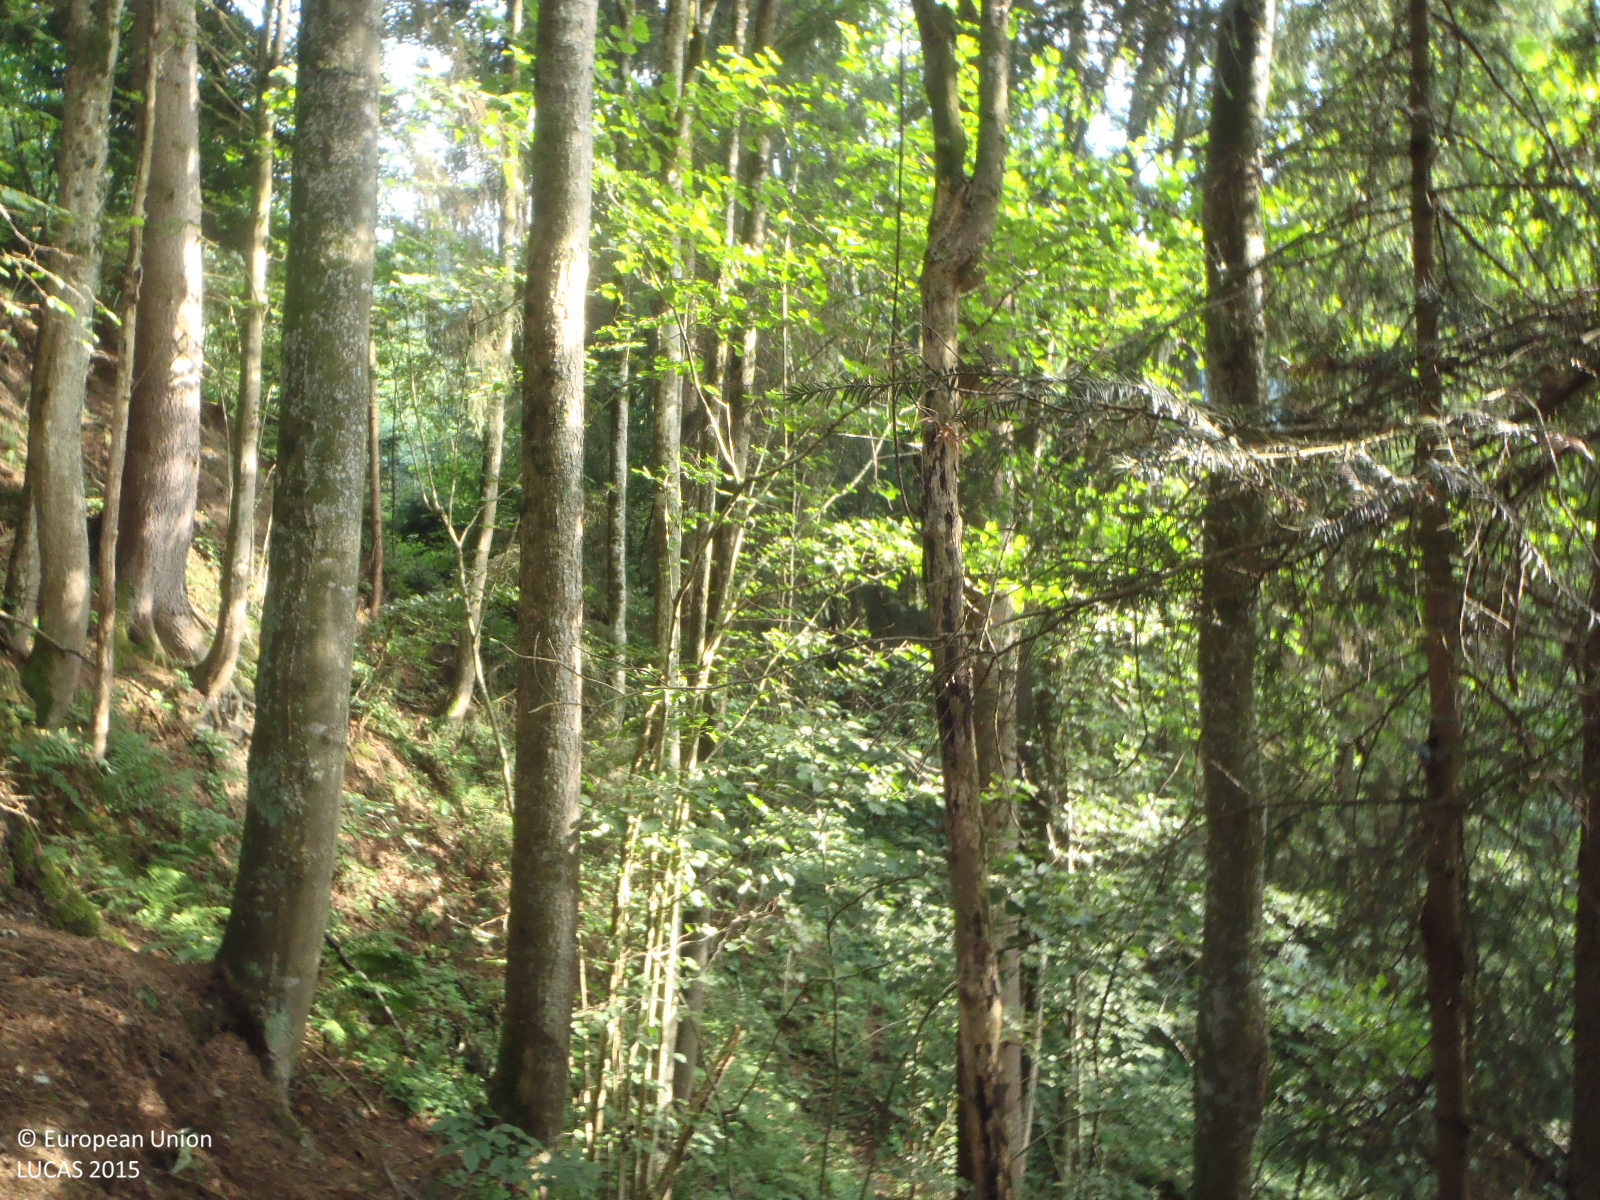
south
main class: Woodland
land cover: Spruce dominated mixed woodland
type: alpine coniferous forest
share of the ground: > 75 %
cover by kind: coniferous forest trees 70 %, broadleaved forest trees 30 %
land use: Forestry
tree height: > 5 m
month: July
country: AT
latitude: 47.4151
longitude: 11.8938
